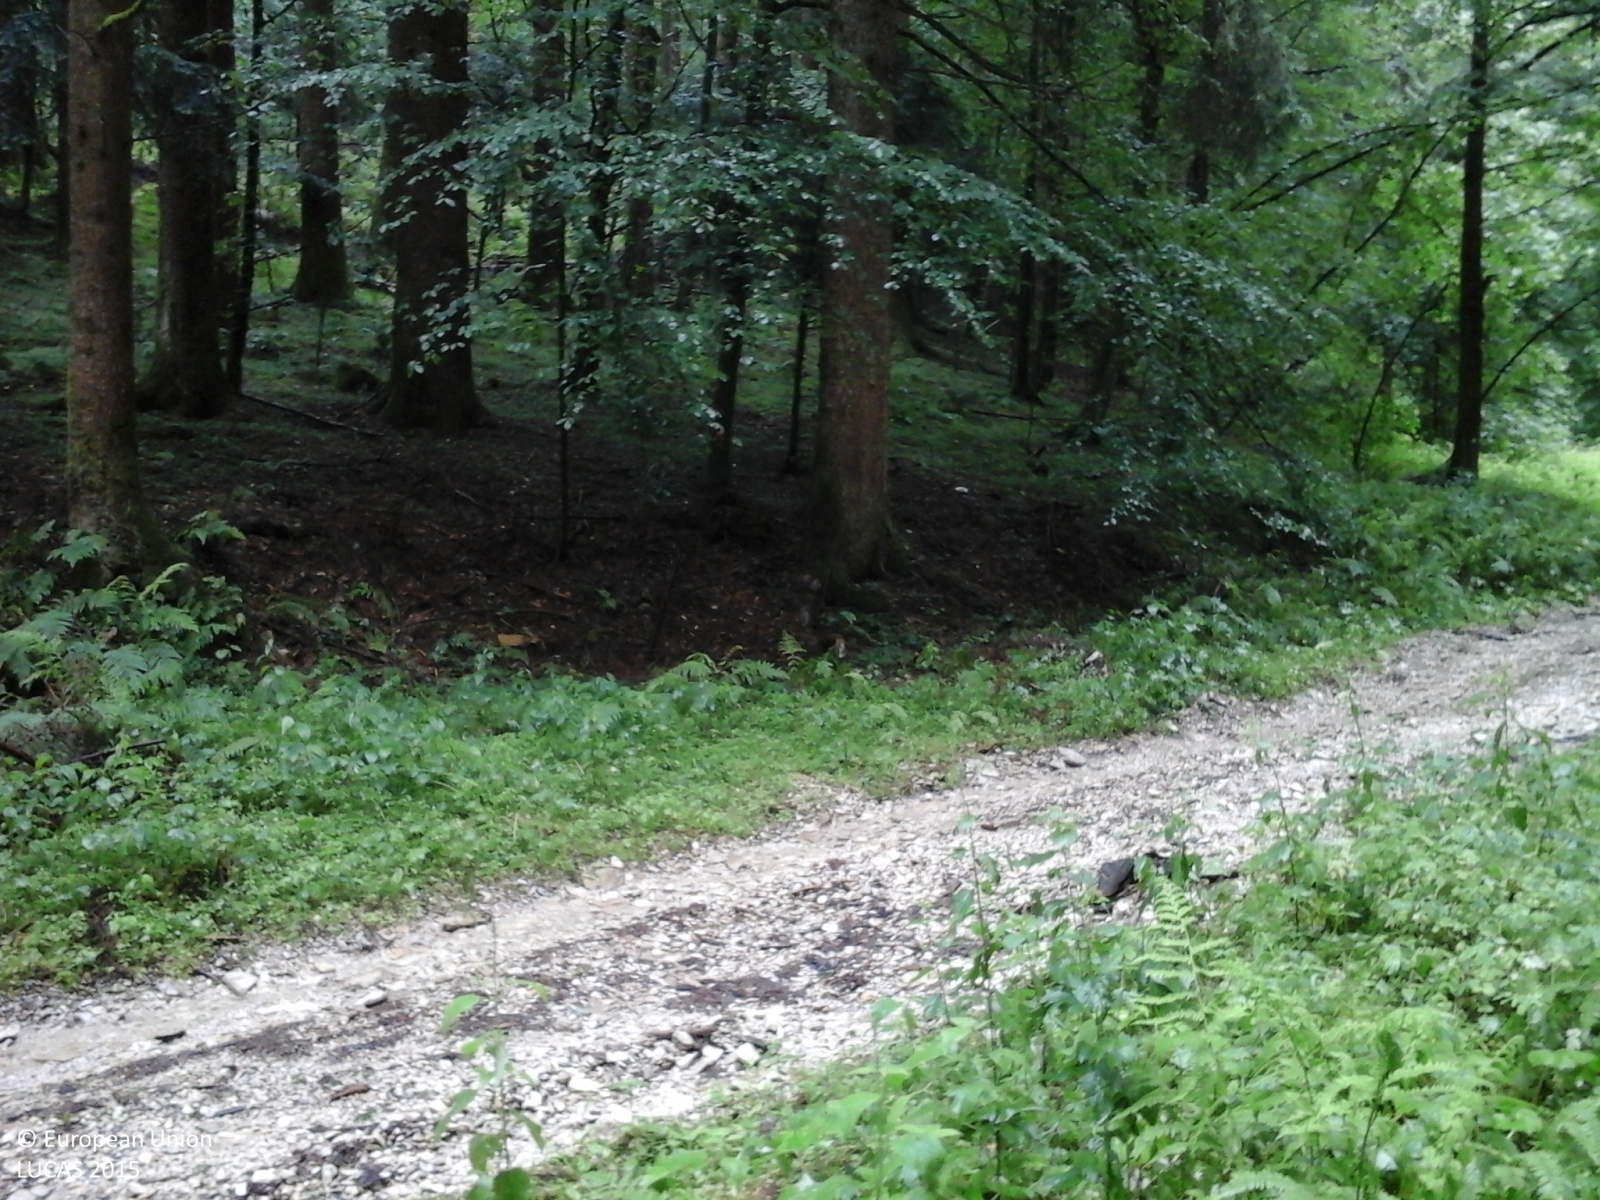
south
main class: Woodland
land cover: Spruce dominated coniferous woodland
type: alpine coniferous forest
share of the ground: > 75 %
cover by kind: coniferous forest trees 80 %, broadleaved forest trees 20 %
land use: Semi-natural and natural areas not in use
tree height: > 5 m
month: June
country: IT
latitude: 45.9059
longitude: 11.6605
